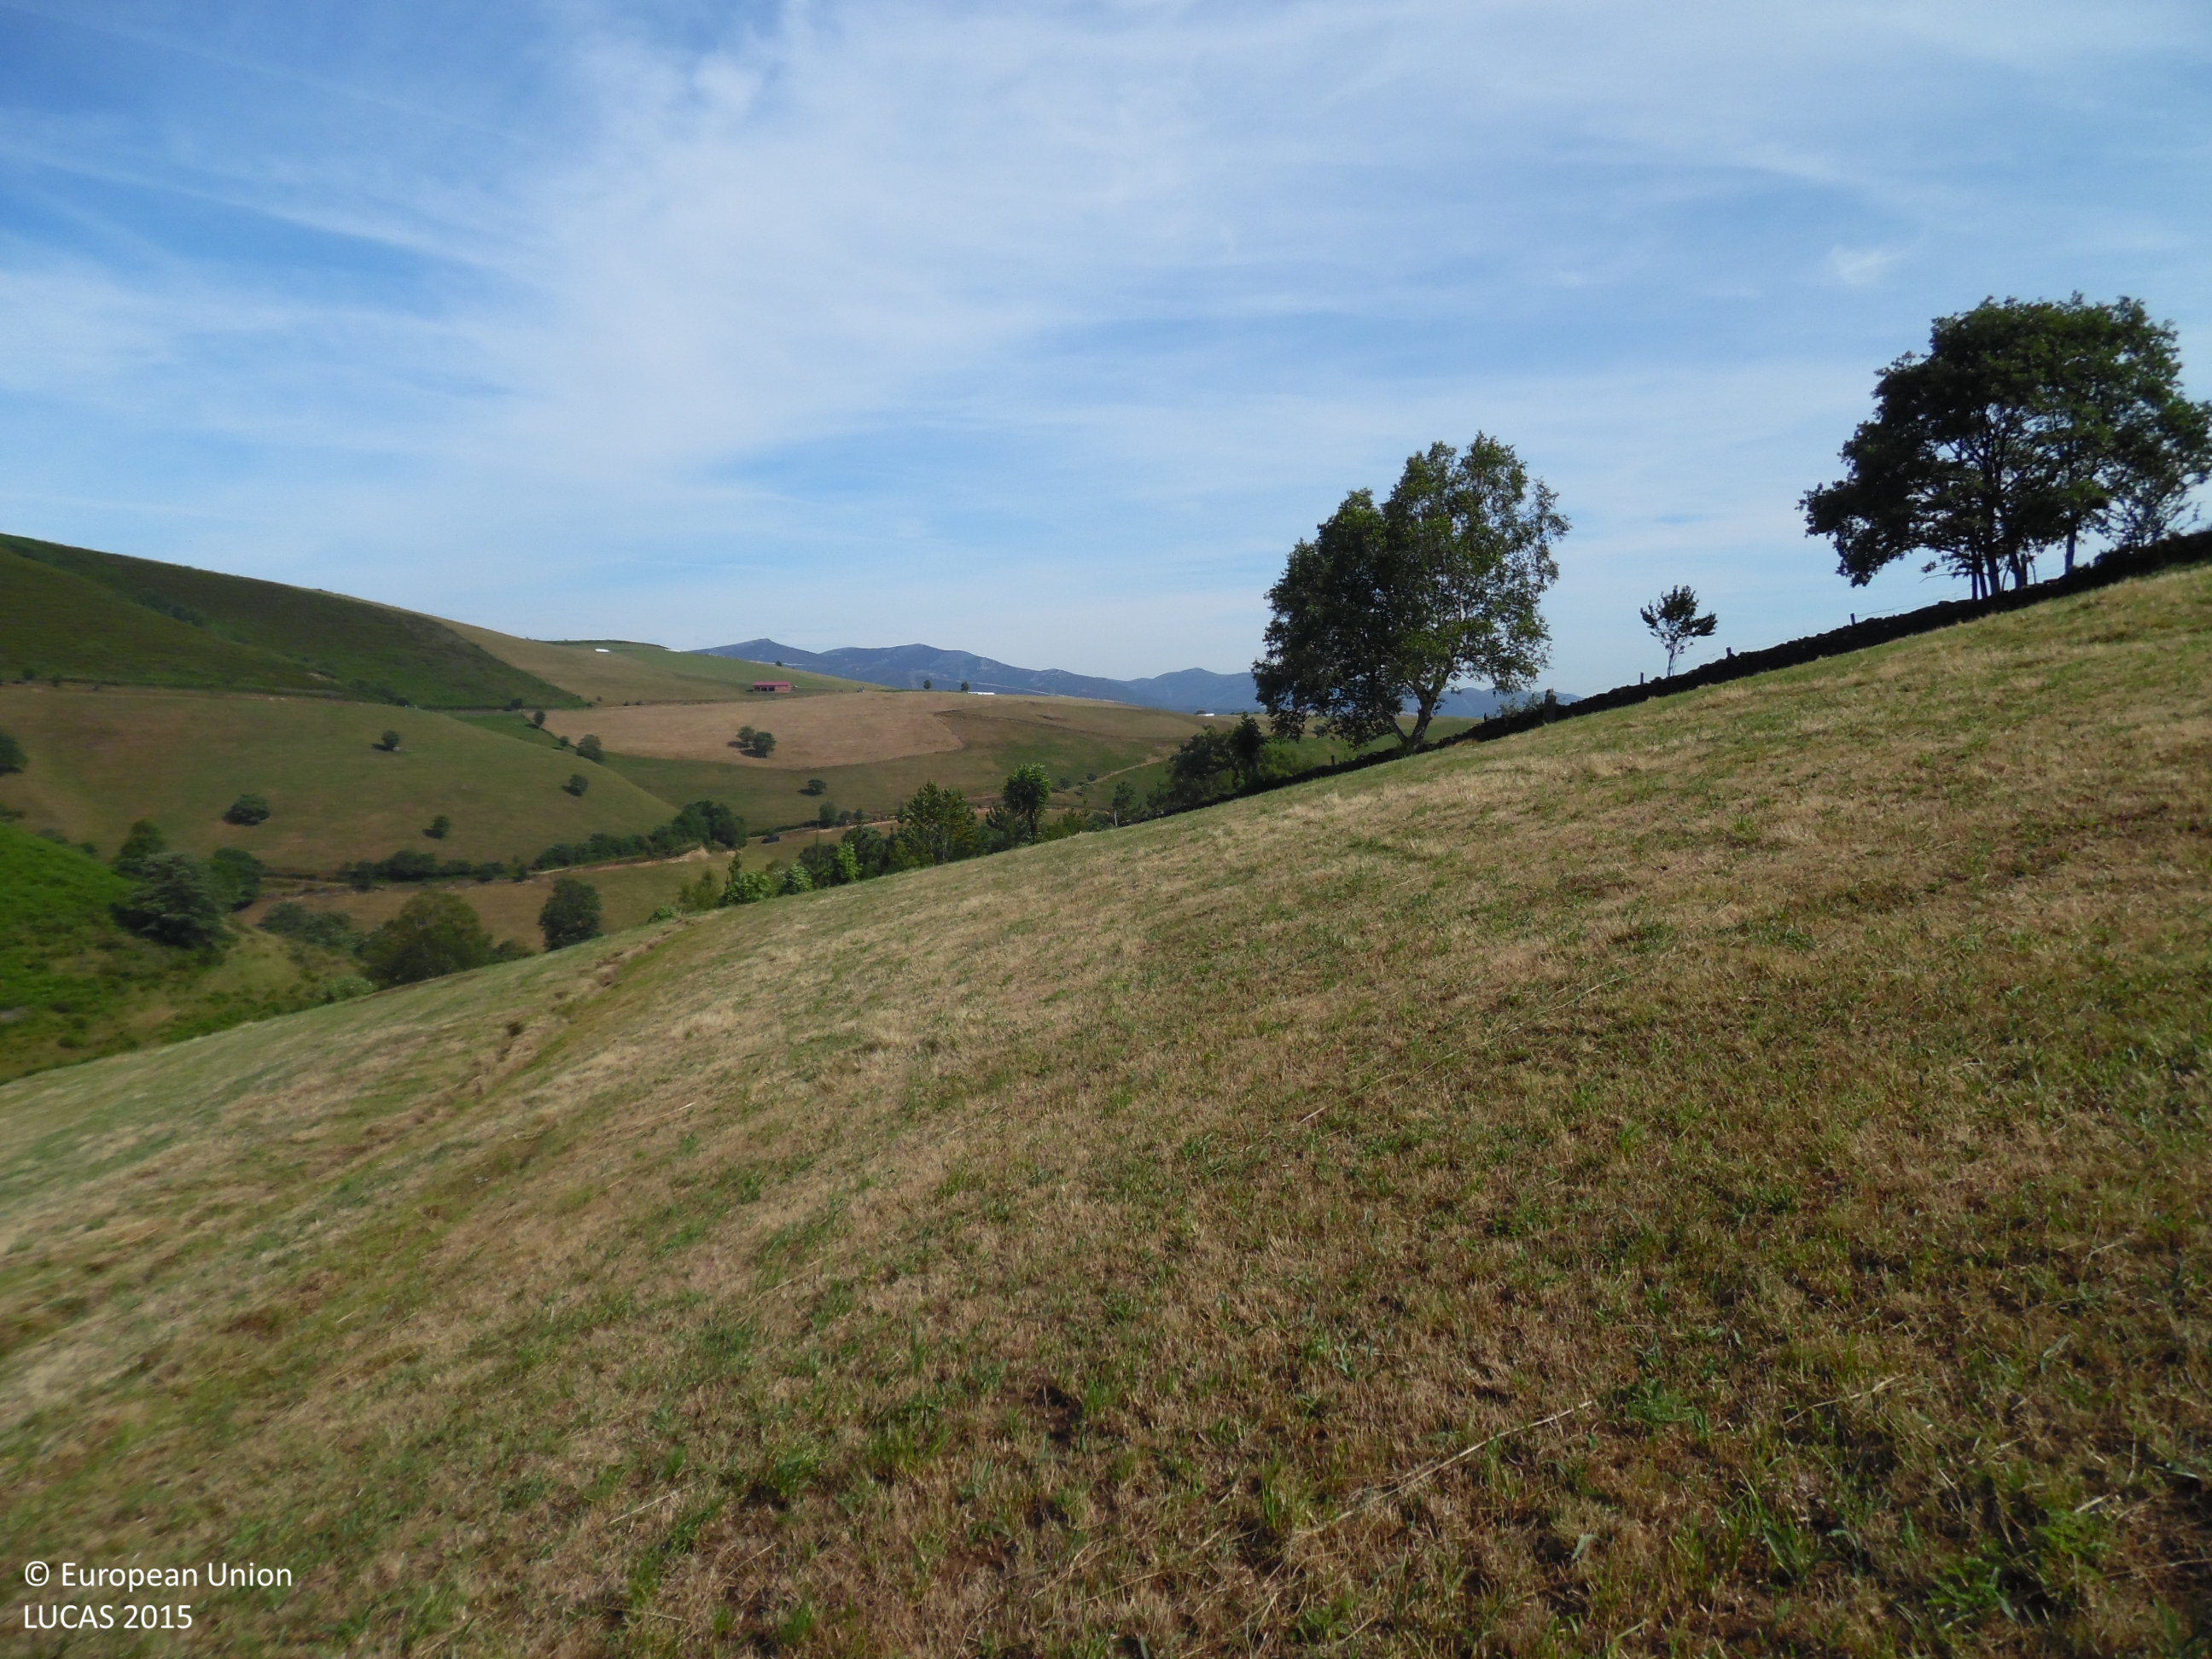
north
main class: Cropland
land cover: Temporary grasslands
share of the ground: > 75 %
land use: Agriculture (excluding fallow land and kitchen gardens)
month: July
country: ES
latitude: 43.1680
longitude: -6.5978
